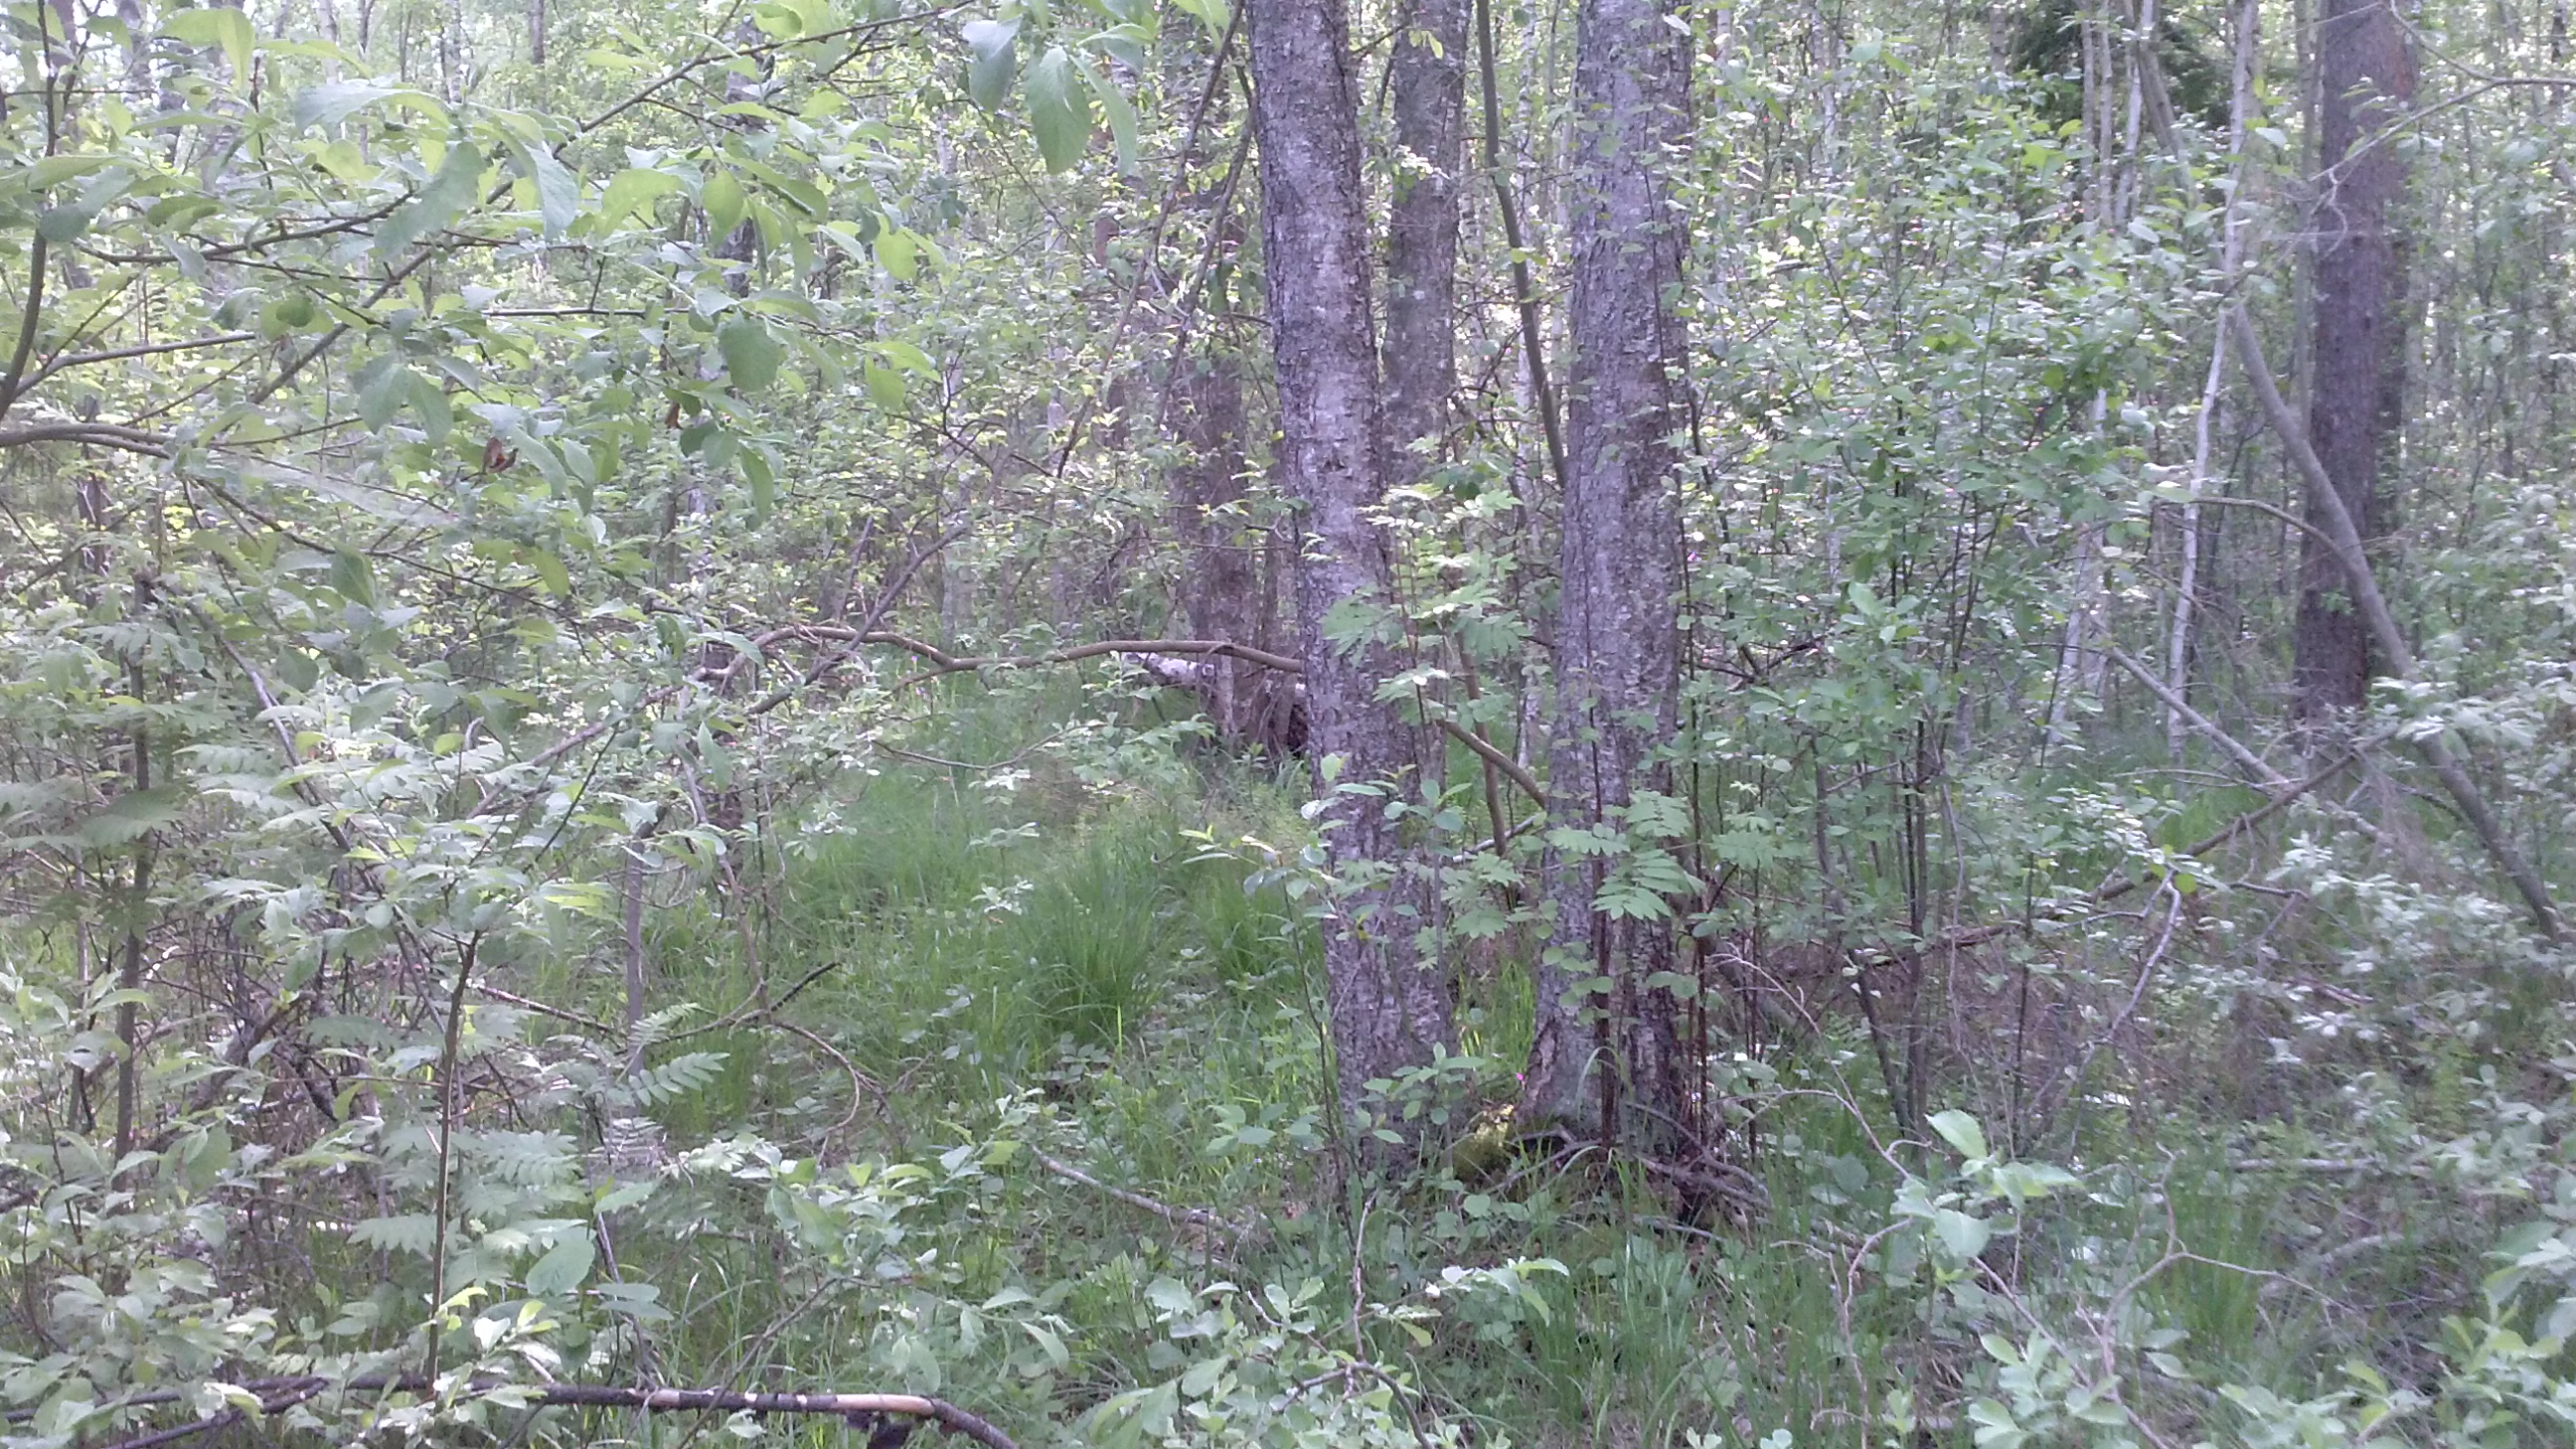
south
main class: Woodland
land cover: Broadleaved woodland
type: non-riverine alder, birch or aspen forest
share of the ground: > 75 %
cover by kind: broadleaved forest trees 85 %, coniferous forest trees 5 %, shrubs 5 %, herbaceous plants 5 %
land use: Forestry
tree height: > 5 m
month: June
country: LV
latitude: 56.3835
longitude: 27.4258
